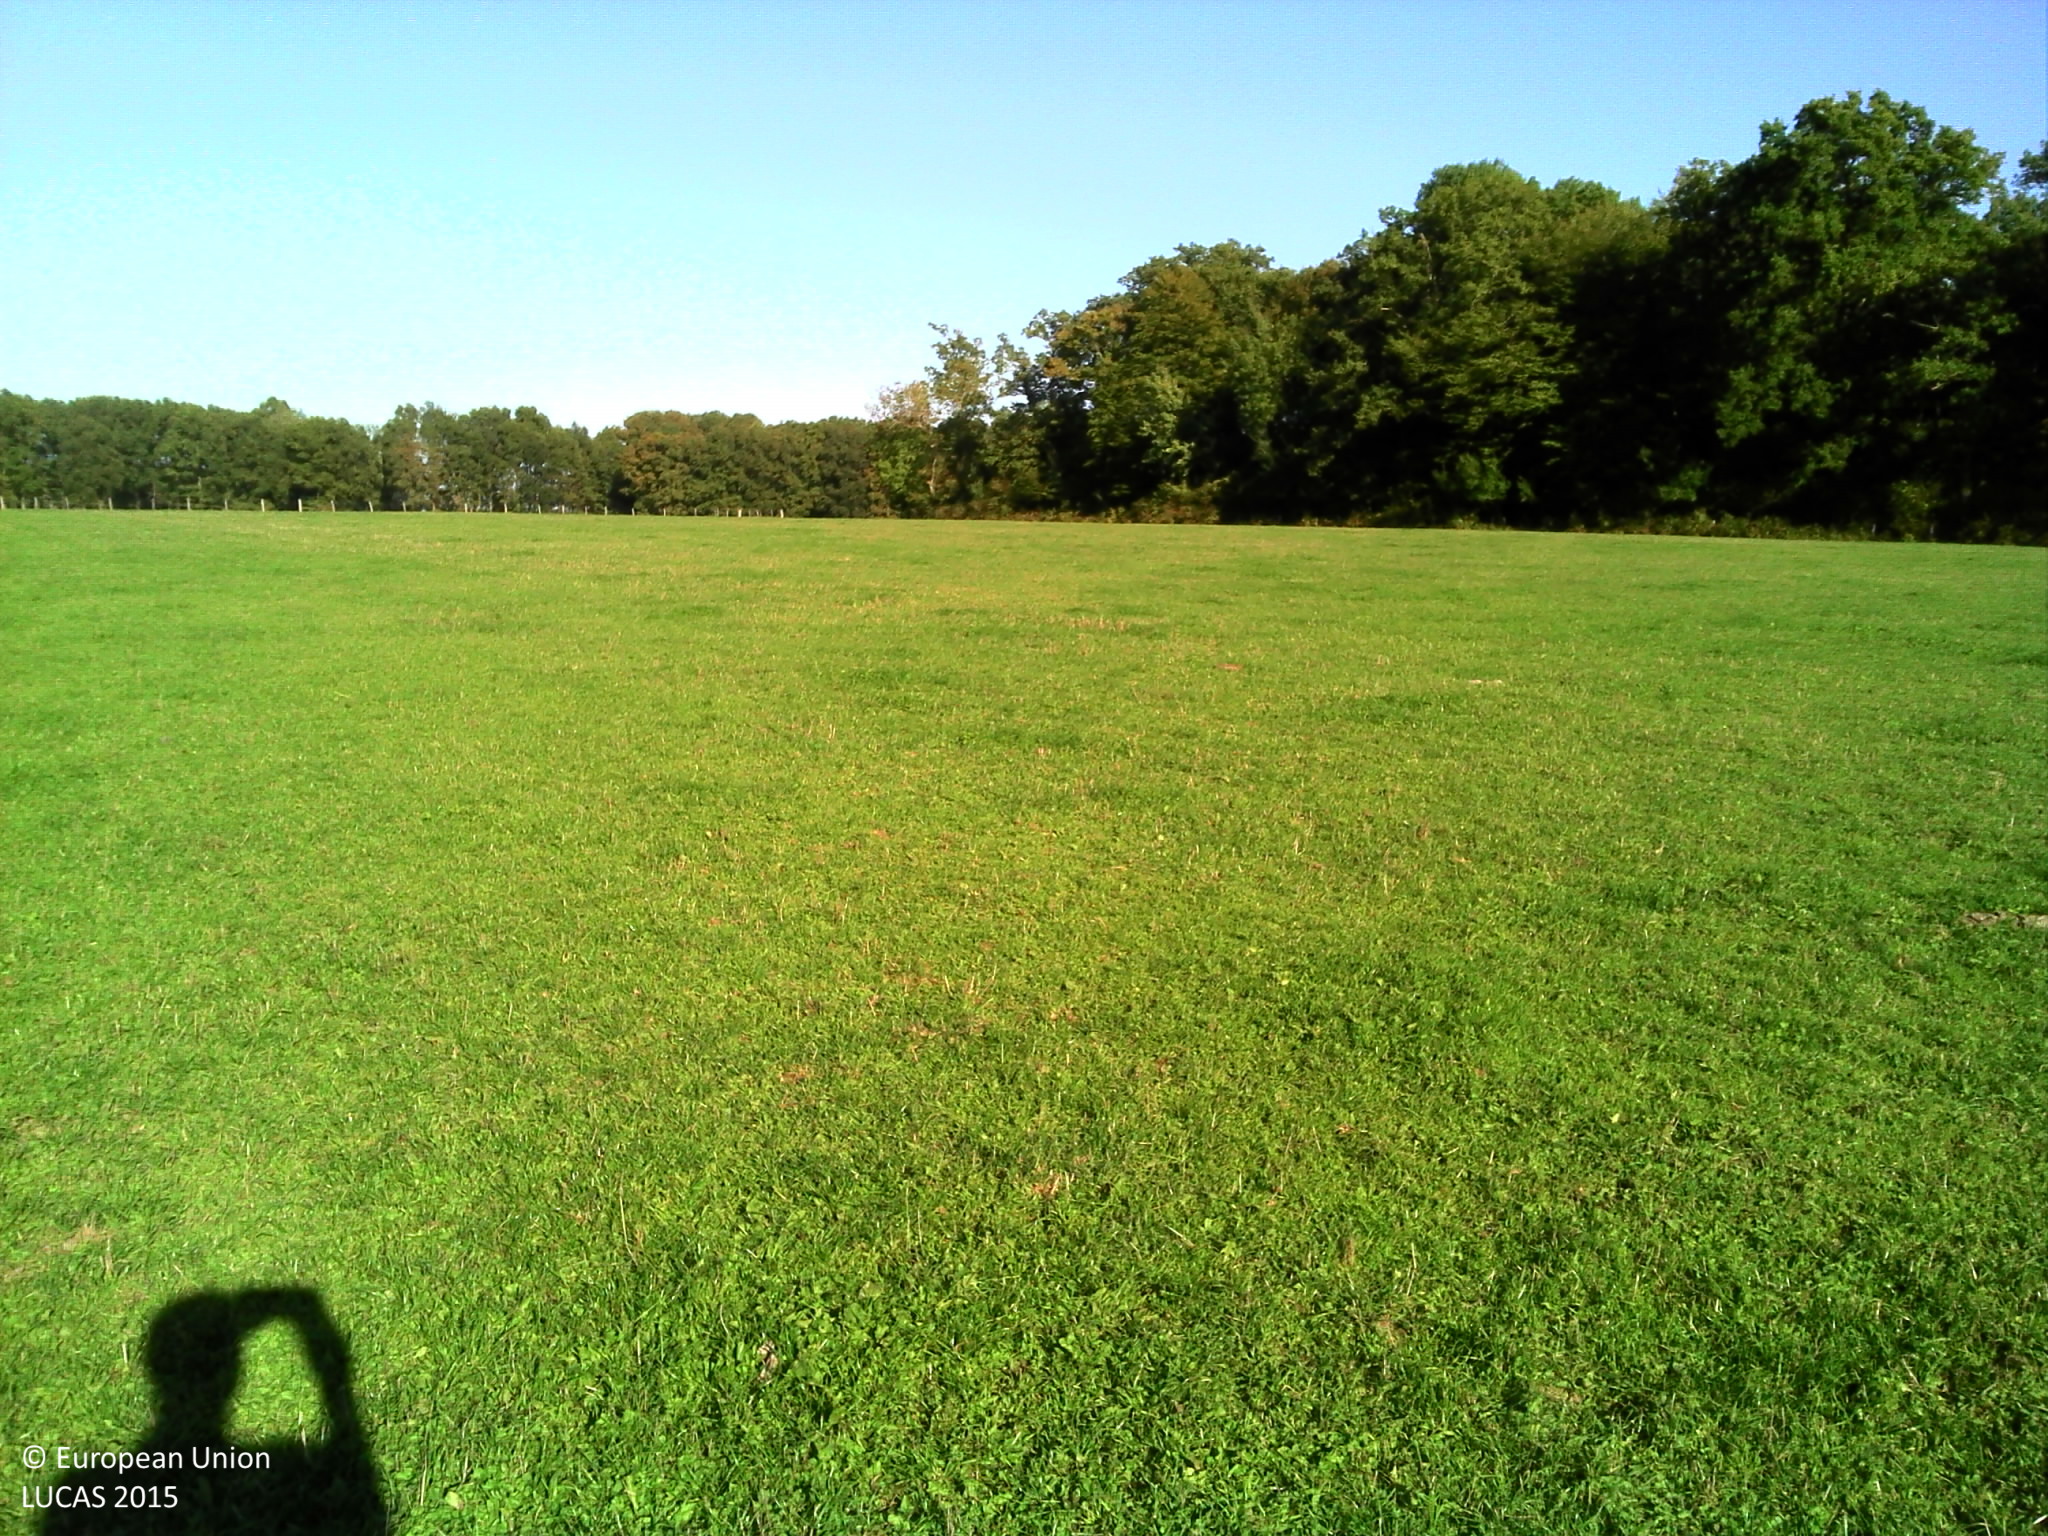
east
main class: Grassland
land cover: Grassland without tree/shrub cover
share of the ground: > 75 %
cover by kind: herbaceous plants 100 %
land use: Agriculture (excluding fallow land and kitchen gardens)
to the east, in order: Grassland without tree/shrub cover; Fences; Broadleaved woodland; Fences; Grassland without tree/shrub cover; Fences; Grassland without tree/shrub cover
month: September
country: FR
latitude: 48.3296
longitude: 4.3183
